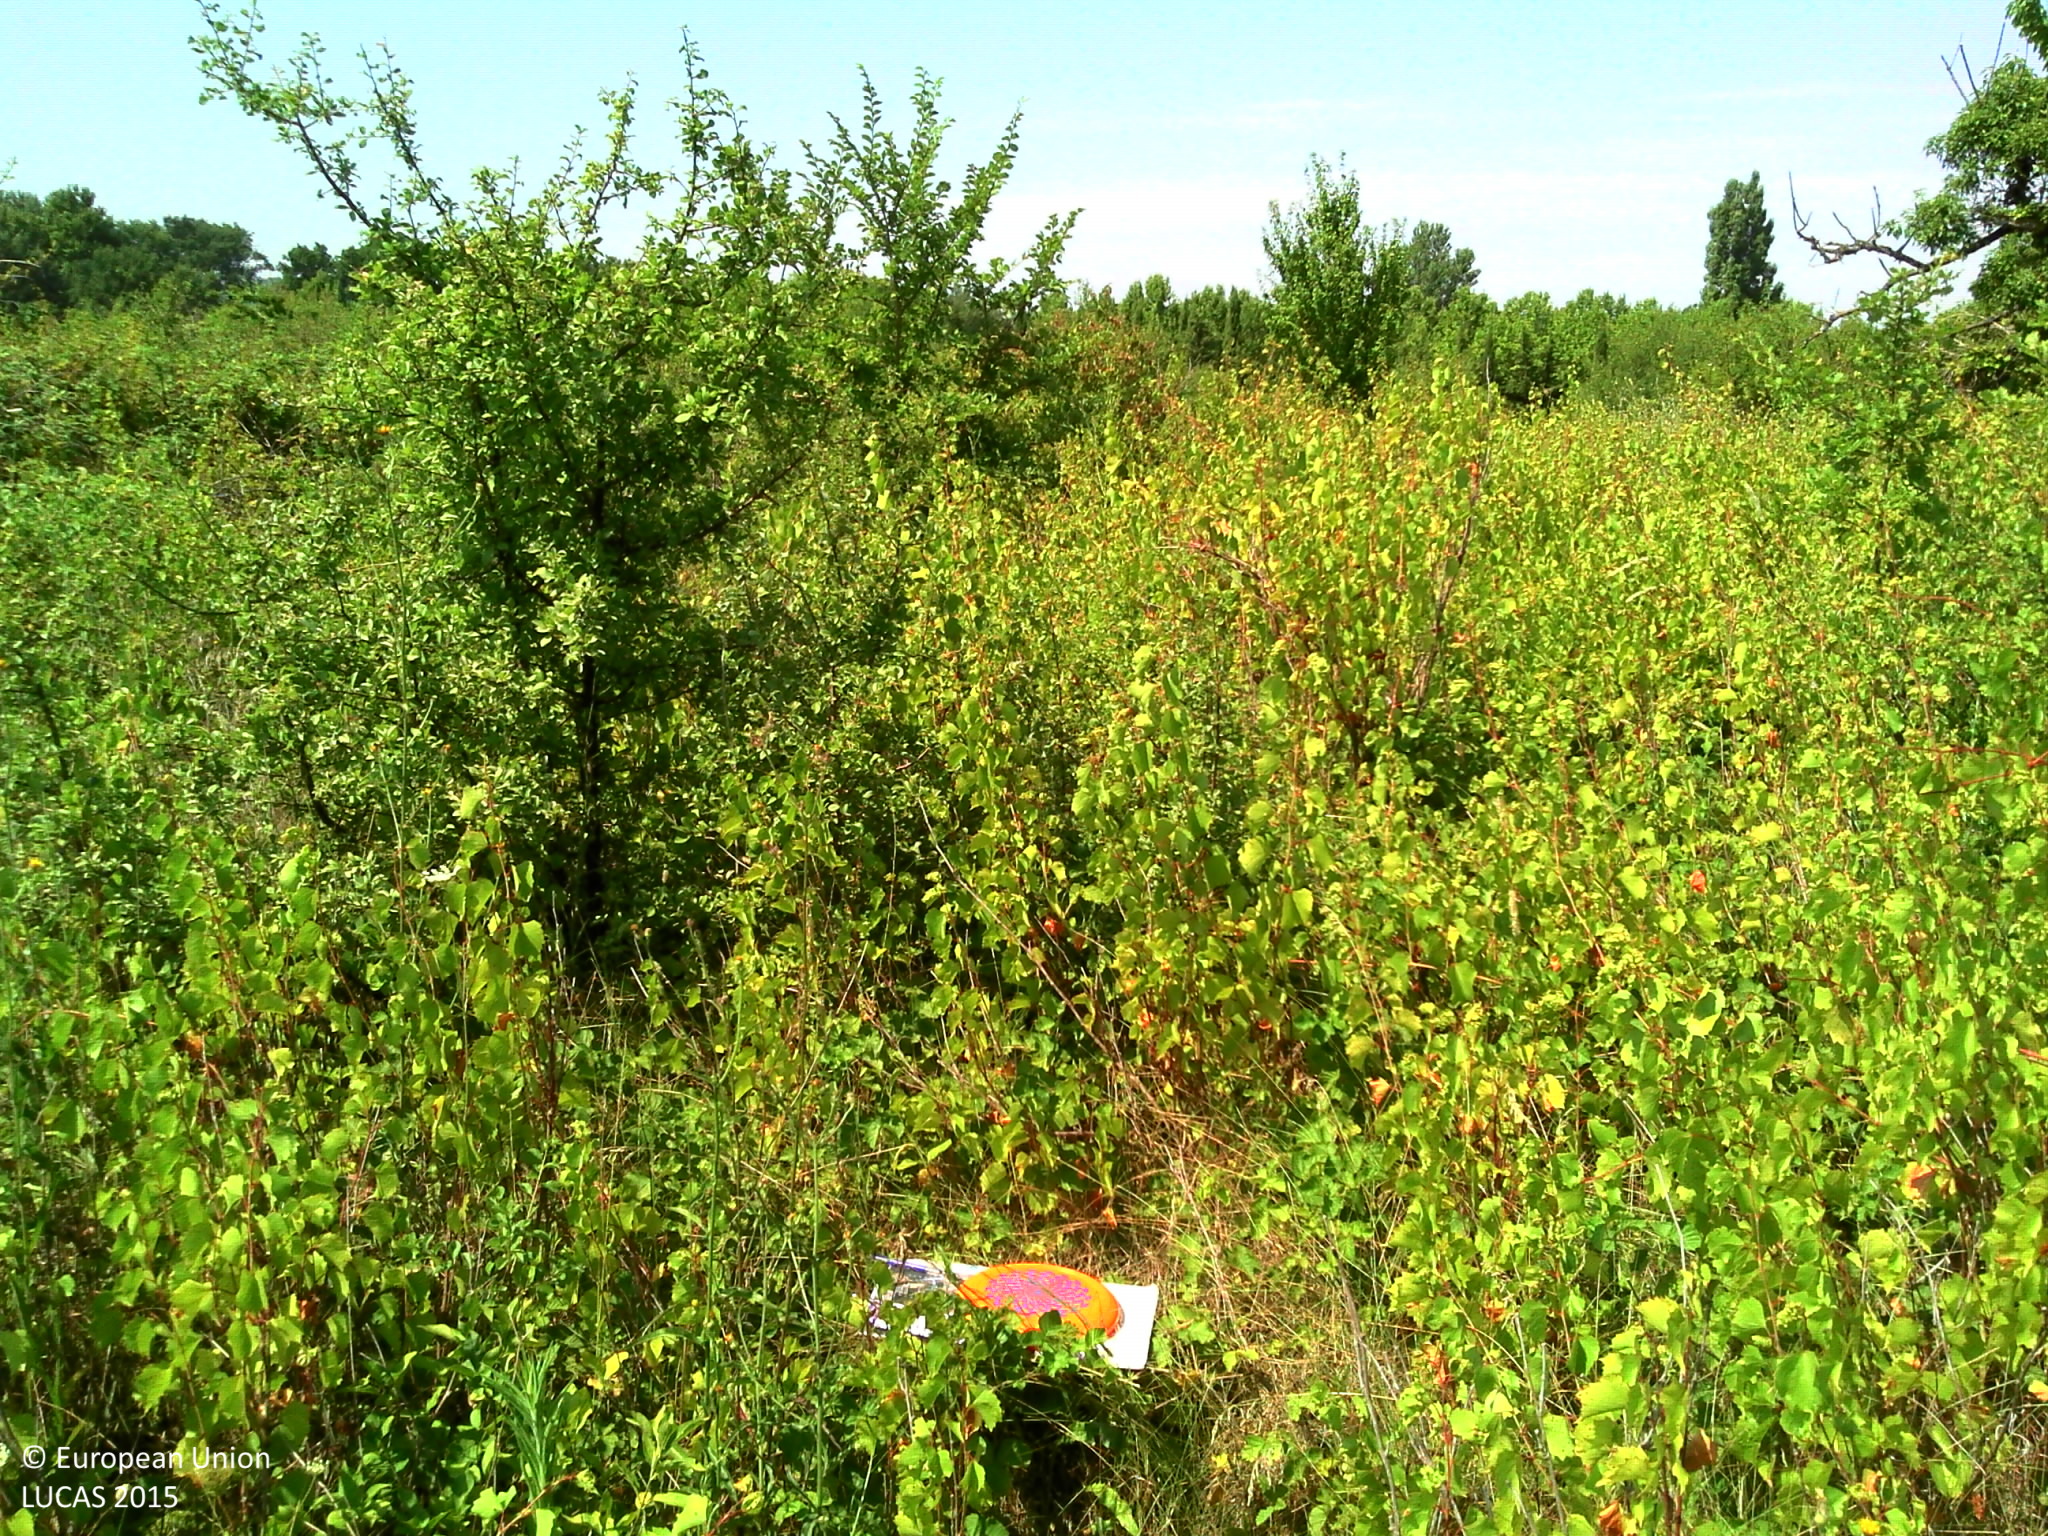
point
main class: Shrubland
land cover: Shrubland with sparse tree cover
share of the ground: > 75 %
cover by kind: shrubs 45 %, herbaceous plants 45 %, broadleaved forest trees 5 %, lichens and mosses 5 %
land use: Semi-natural and natural areas not in use
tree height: < 5 m
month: July
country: FR
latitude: 43.9991
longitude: 5.0825
